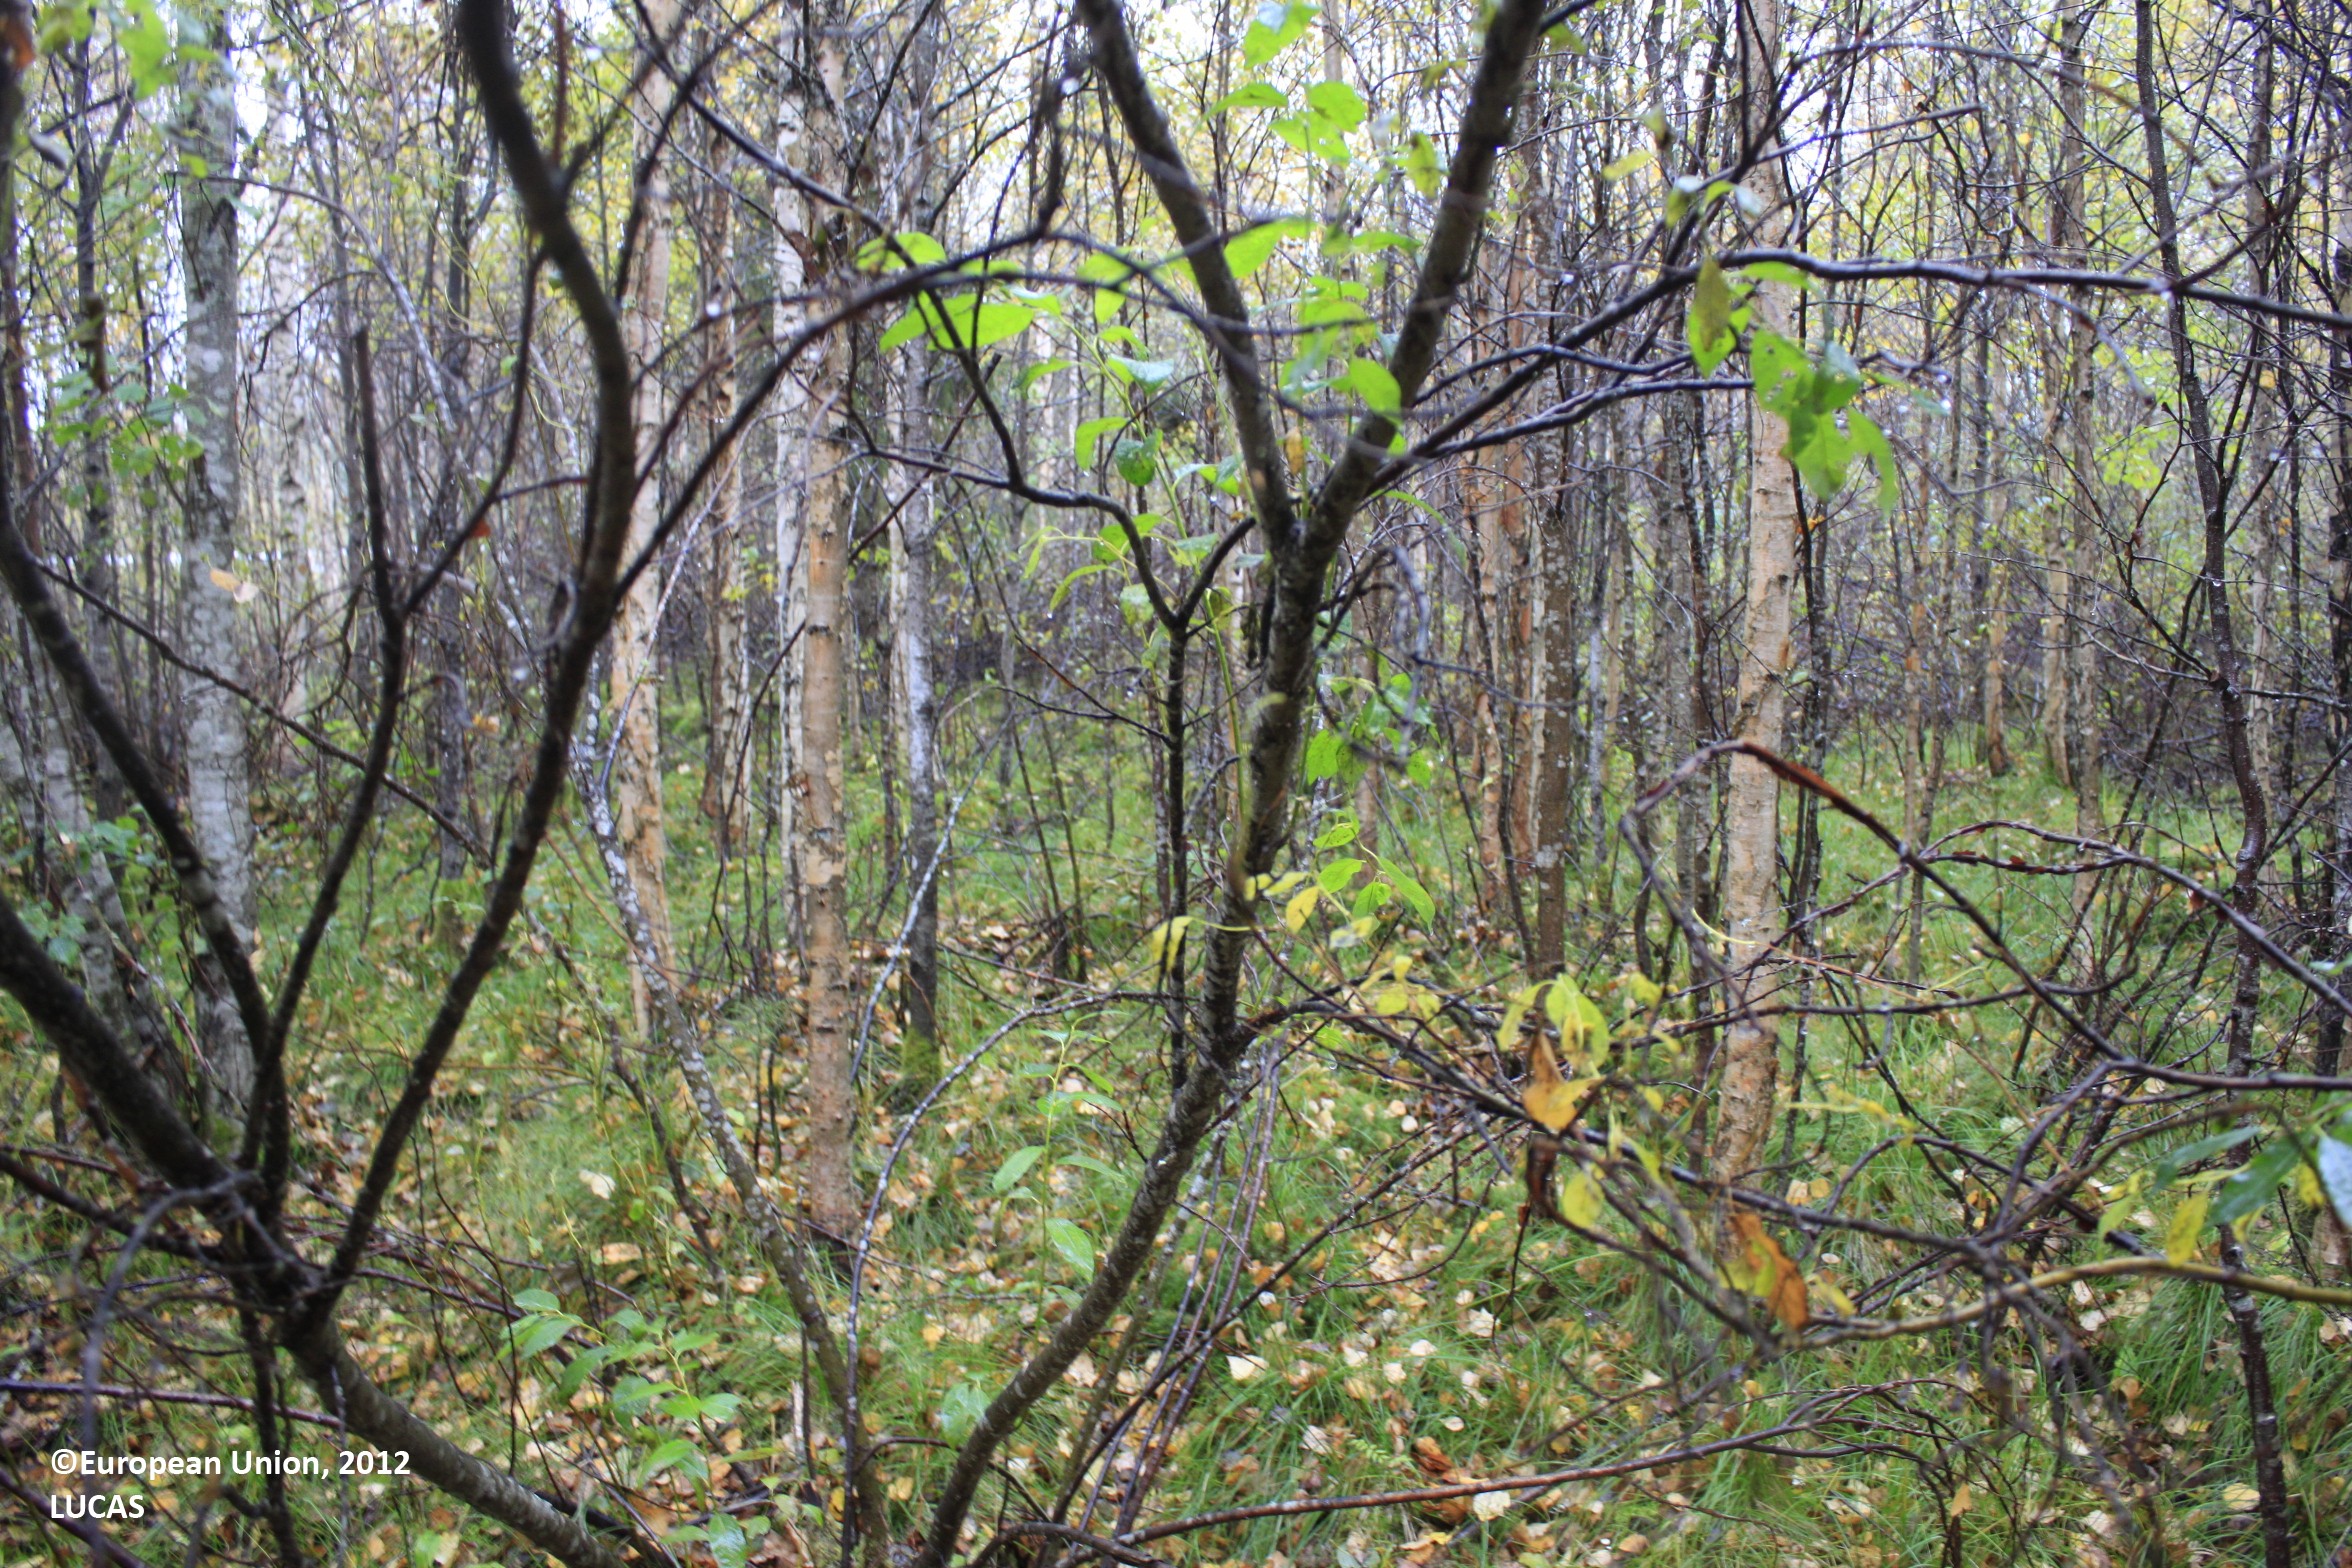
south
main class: Woodland
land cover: Broadleaved woodland
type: boreal forest
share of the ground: > 75 %
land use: Forestry
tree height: > 5 m
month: September
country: FI
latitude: 65.6406
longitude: 27.3981
